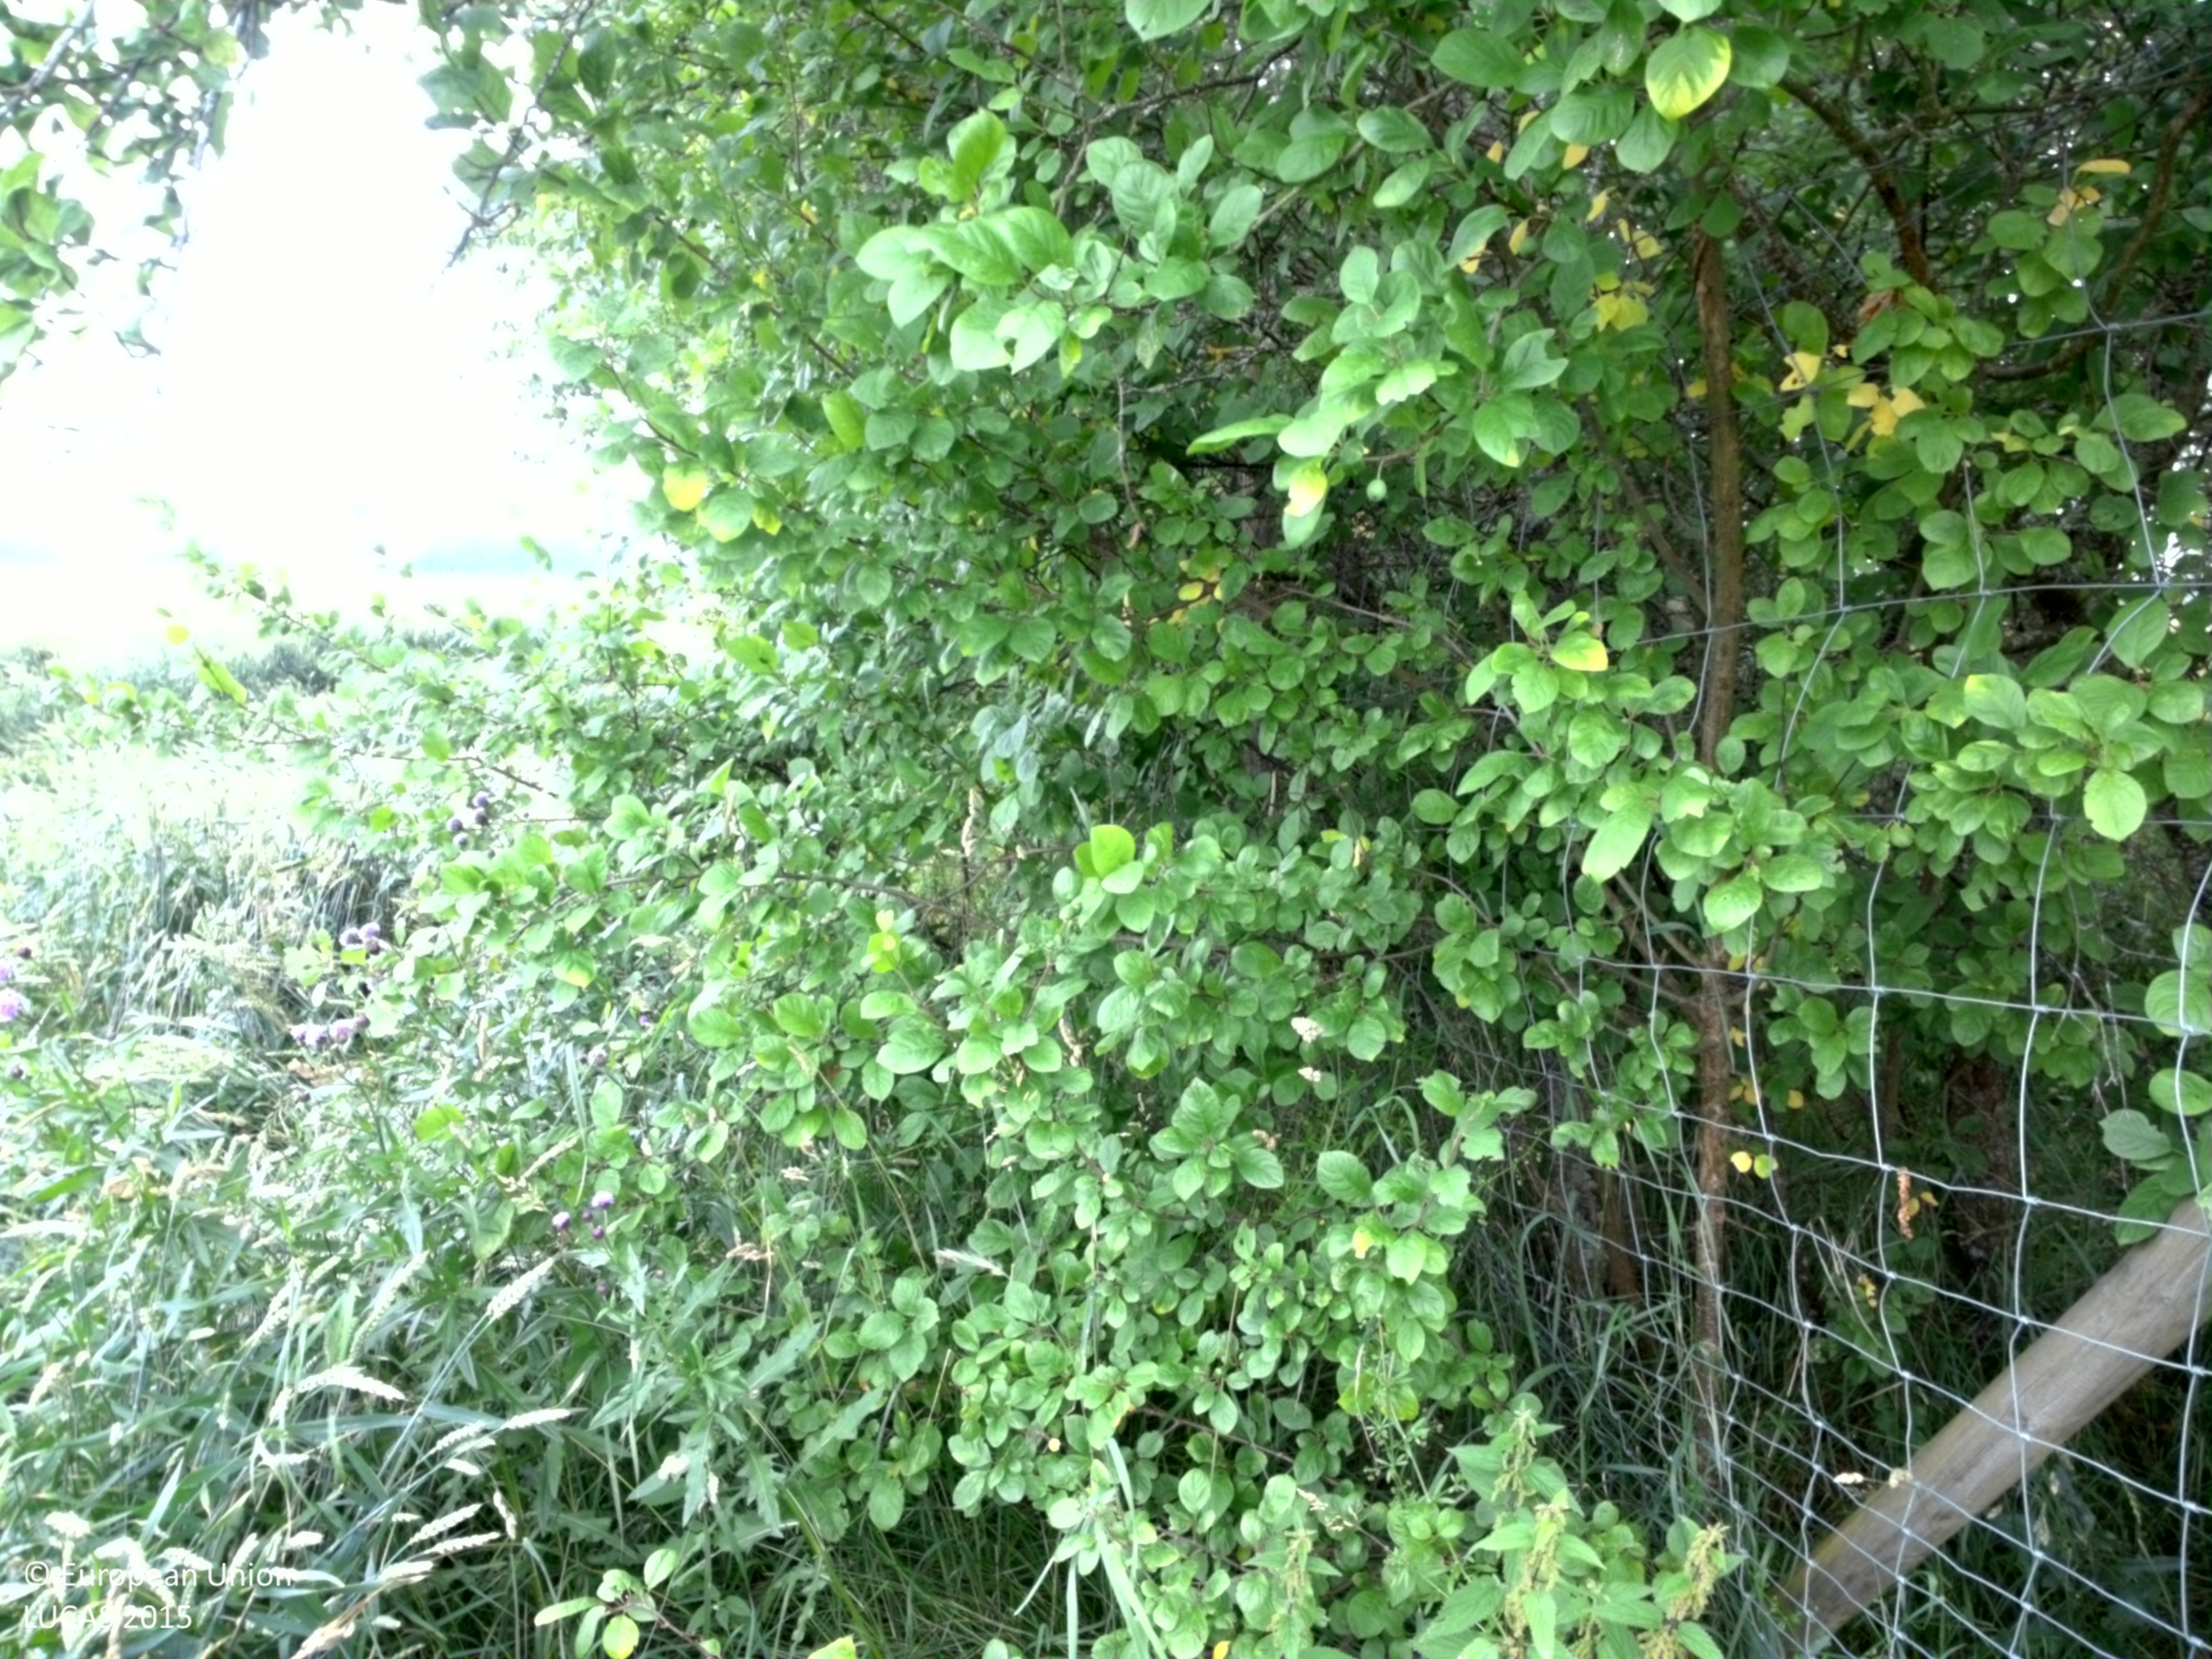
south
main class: Cropland
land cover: Common wheat
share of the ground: > 75 %
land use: Agriculture (excluding fallow land and kitchen gardens)
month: July
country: SE
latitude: 58.3780
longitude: 13.2604
